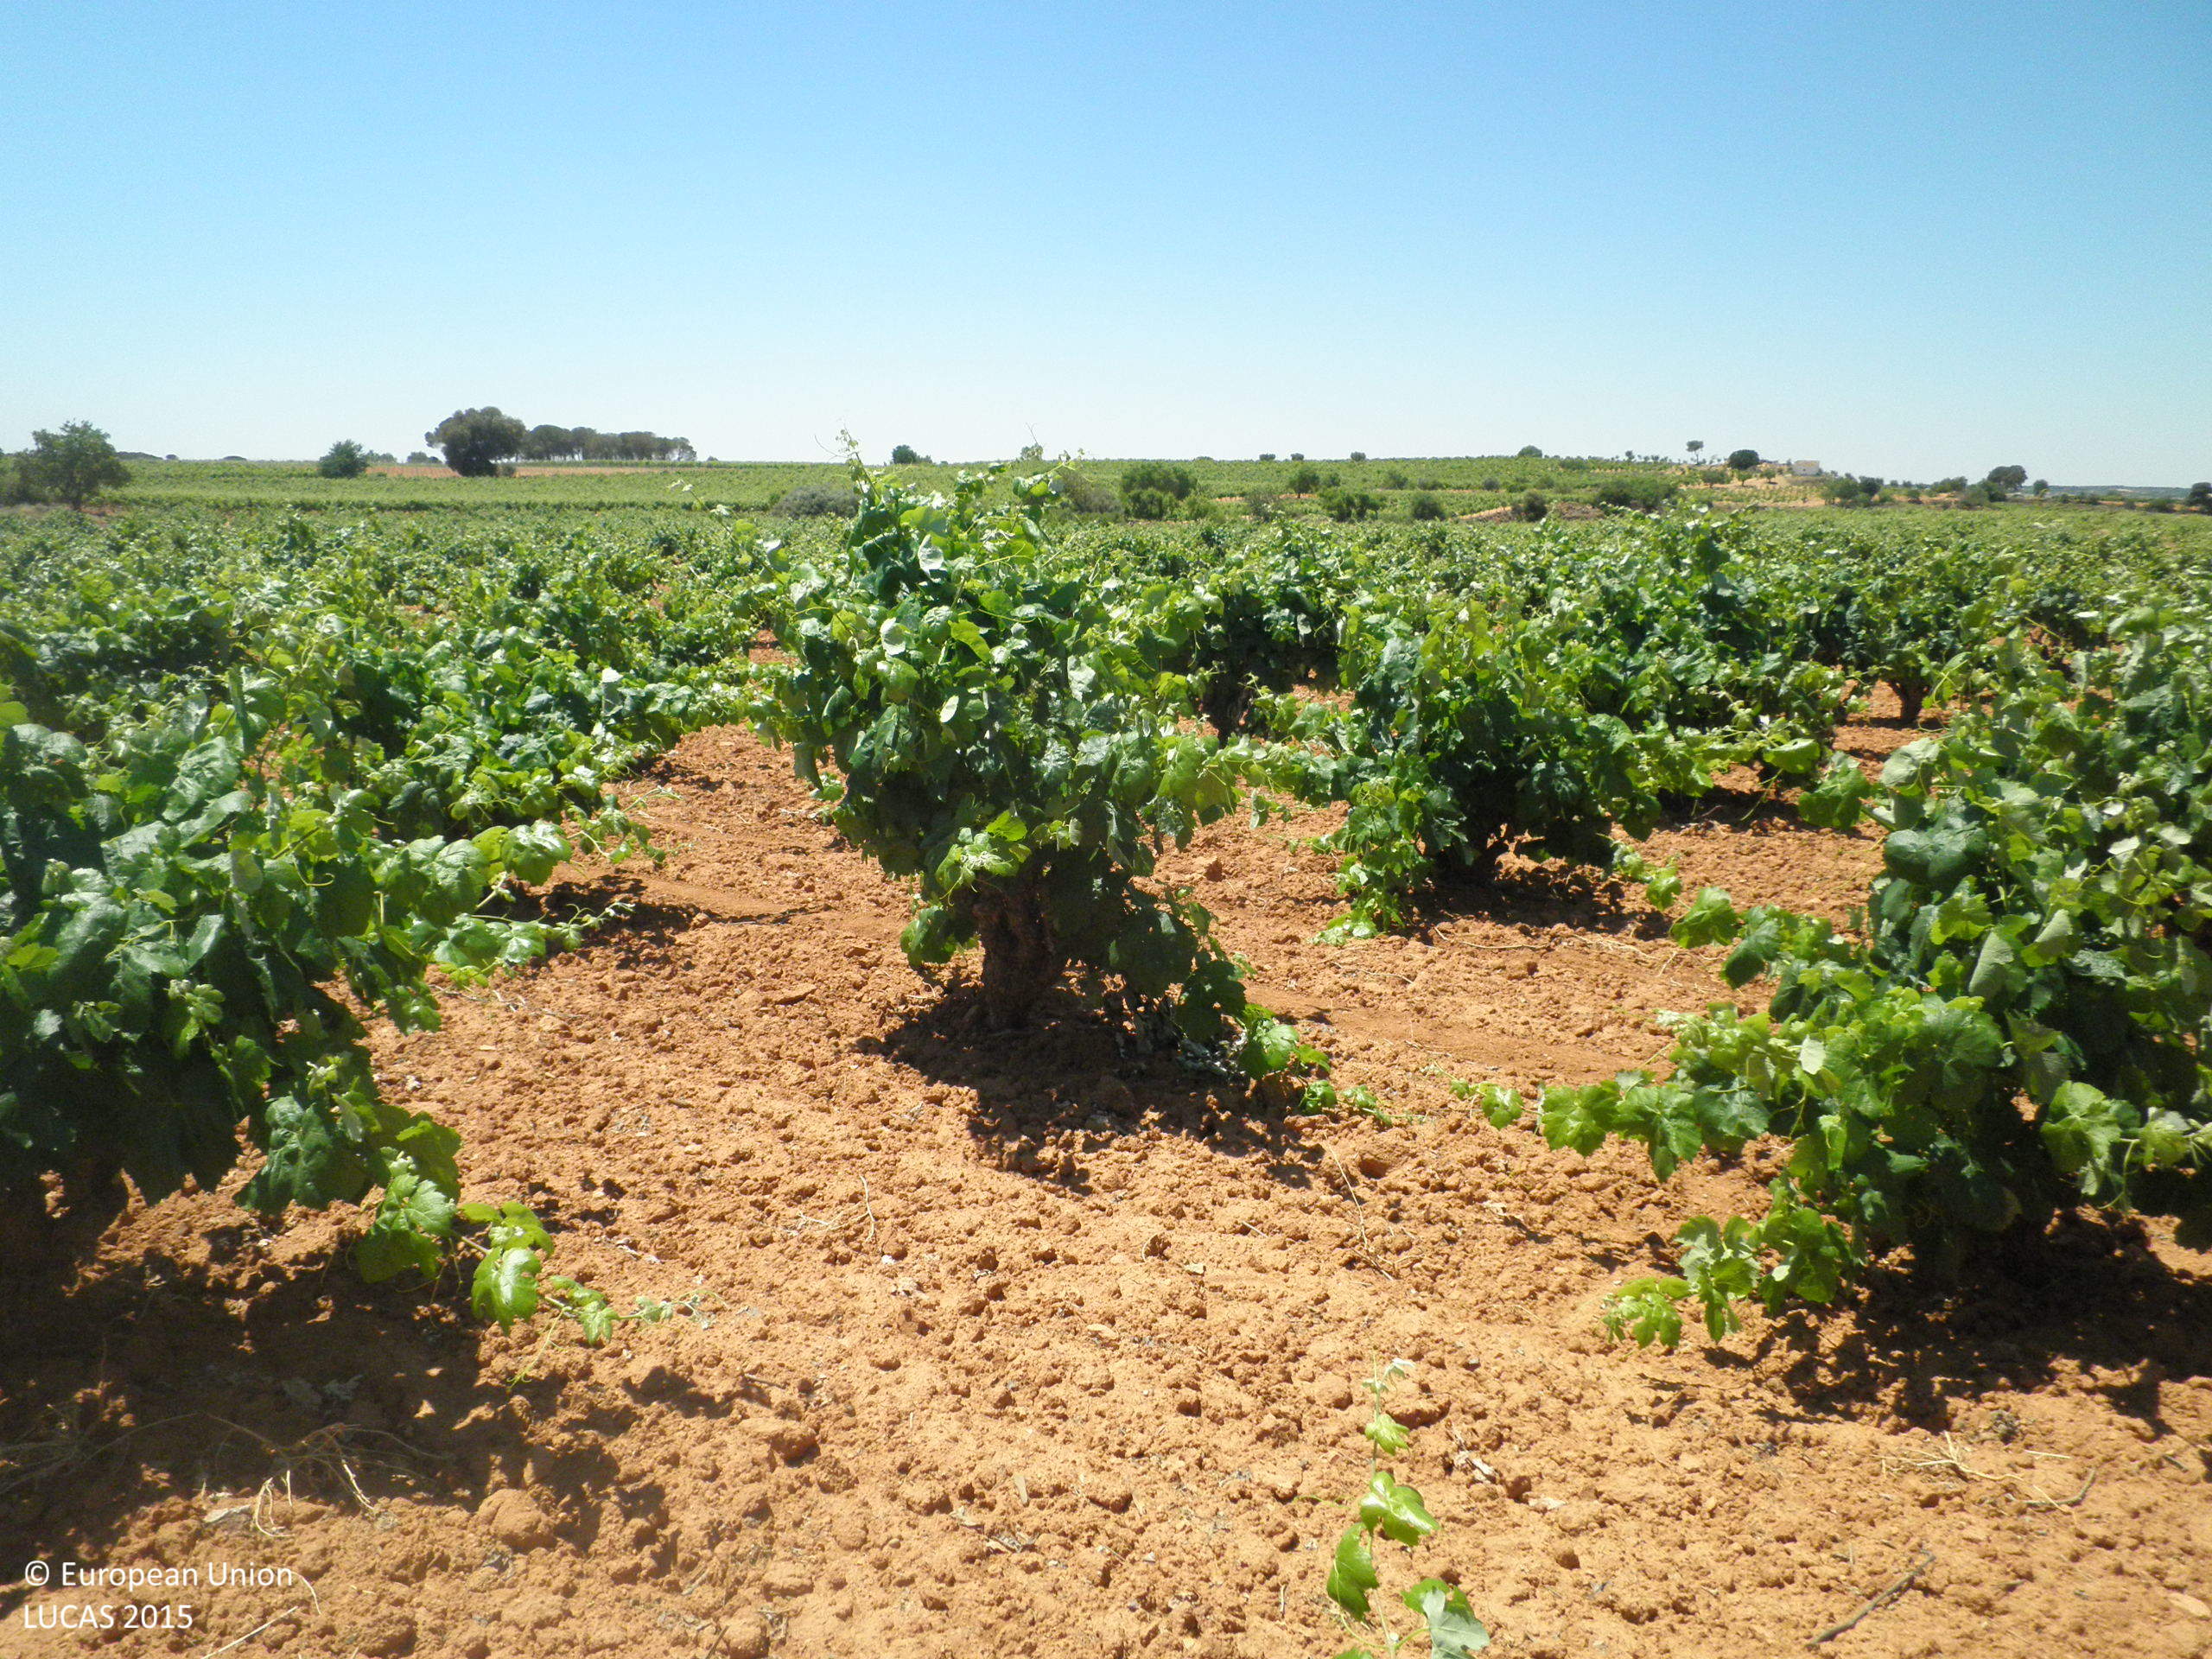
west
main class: Cropland
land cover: Vineyards
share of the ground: 10 - 25 %
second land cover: Other bare soil
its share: > 75 %
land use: Agriculture (excluding fallow land and kitchen gardens)
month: June
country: ES
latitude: 39.4749
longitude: -1.6879
